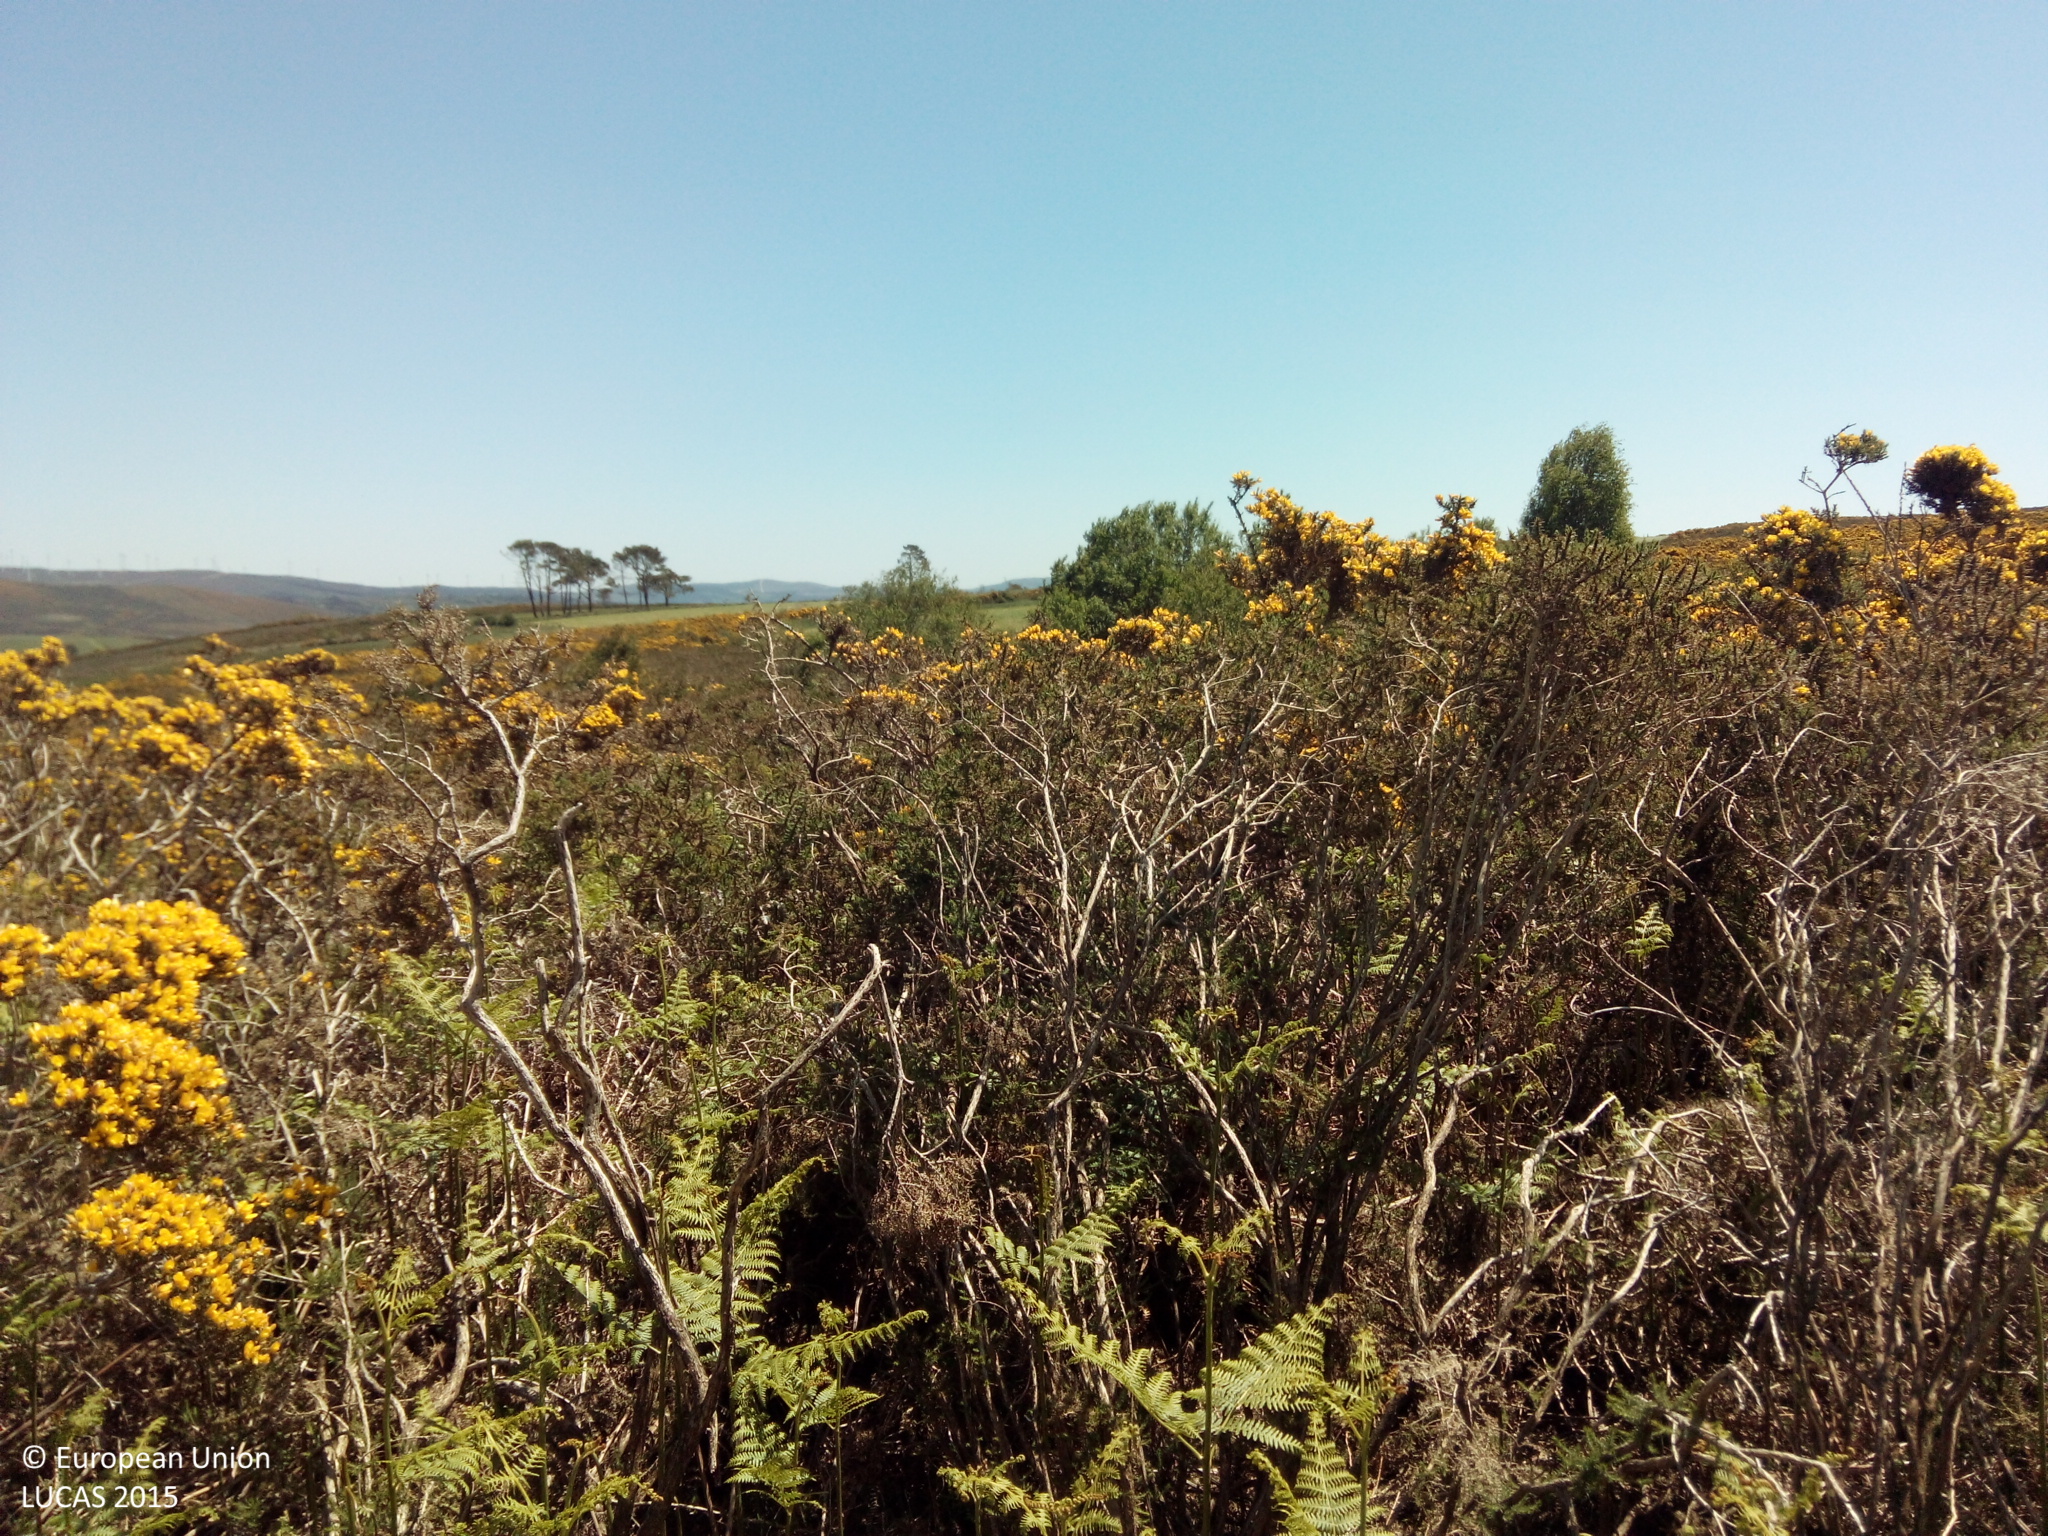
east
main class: Shrubland
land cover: Shrubland without tree cover
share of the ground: > 75 %
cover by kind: shrubs 100 %
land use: Abandoned areas
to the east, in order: Shrubland without tree cover; Fences; Grassland without tree/shrub cover; Ditches and canals; Grass margins; Tracks; Ditches and canals; Shrubland without tree cover
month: May
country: ES
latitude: 42.6234
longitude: -8.3474
